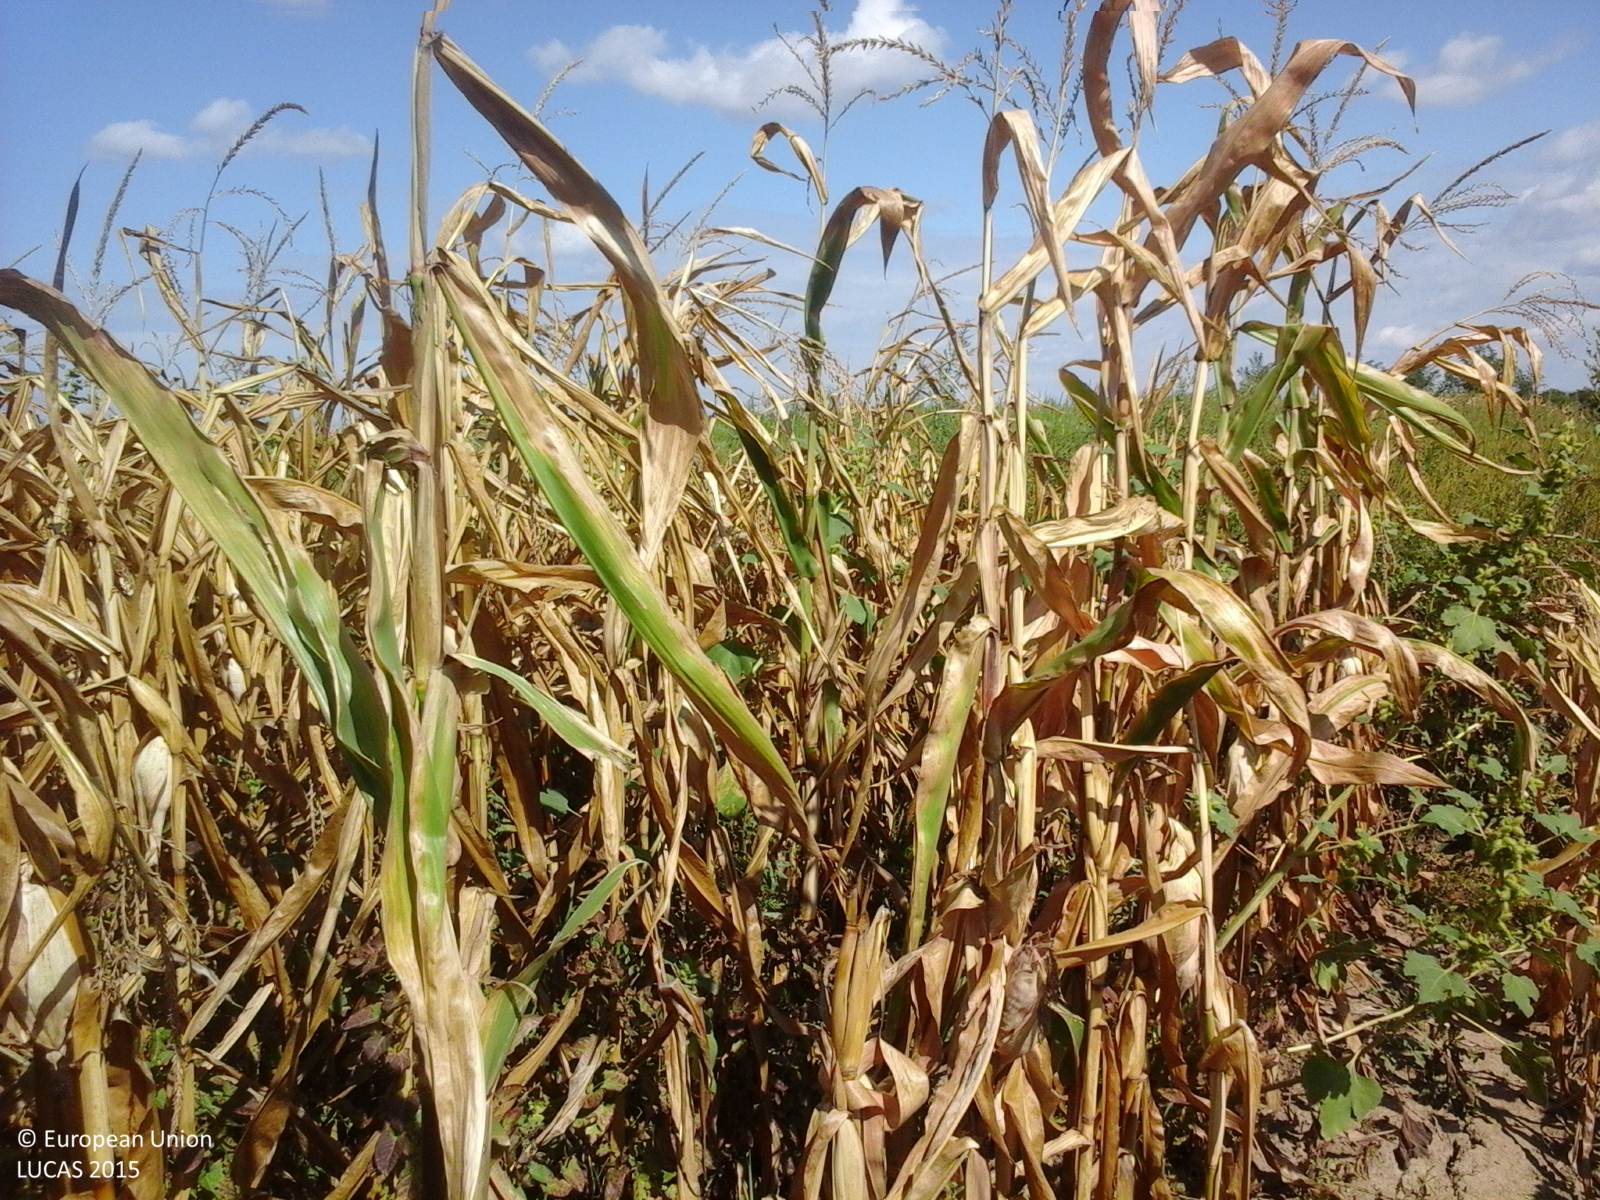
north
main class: Cropland
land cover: Maize
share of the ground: > 75 %
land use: Agriculture (excluding fallow land and kitchen gardens)
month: September
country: RO
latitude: 47.7989
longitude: 22.9766
